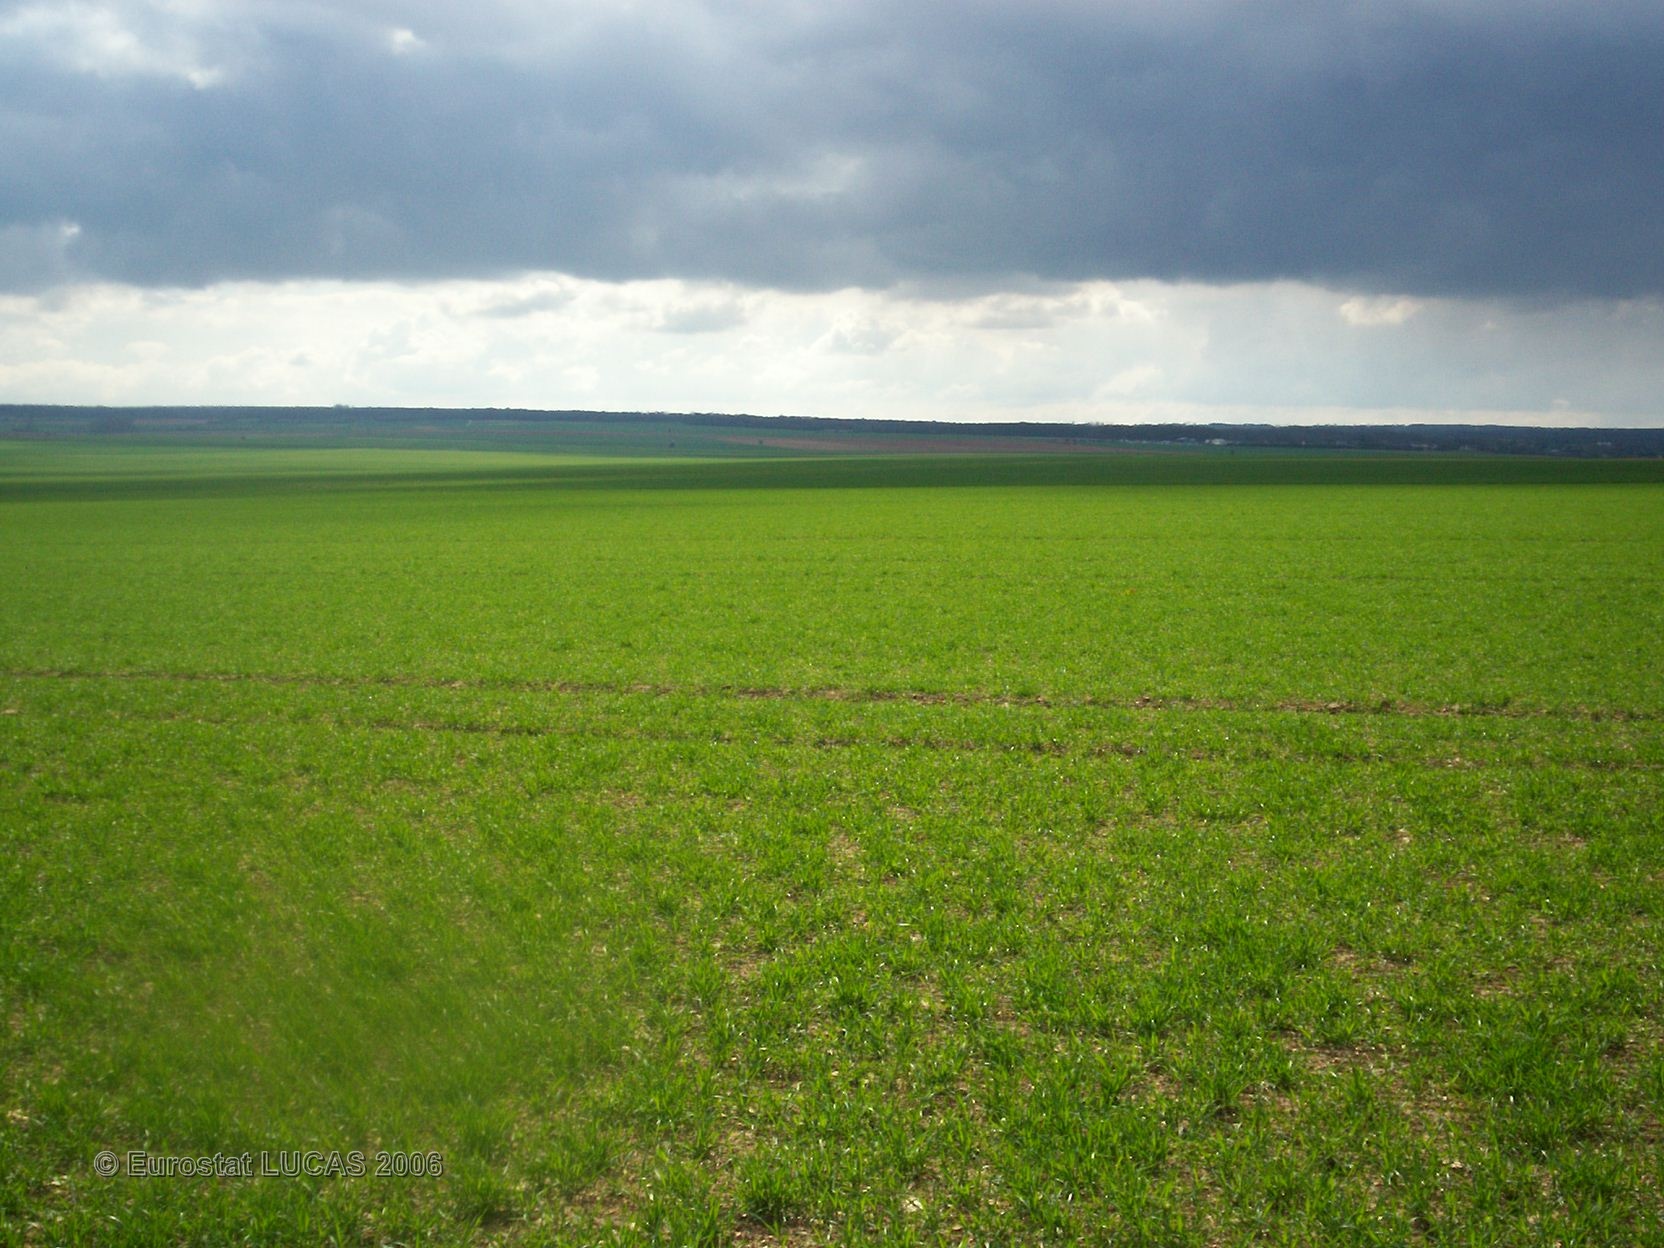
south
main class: Cropland
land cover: Common wheat
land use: Agriculture (excluding fallow land and kitchen gardens)
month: April
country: FR
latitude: 48.8689
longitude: -0.0513
